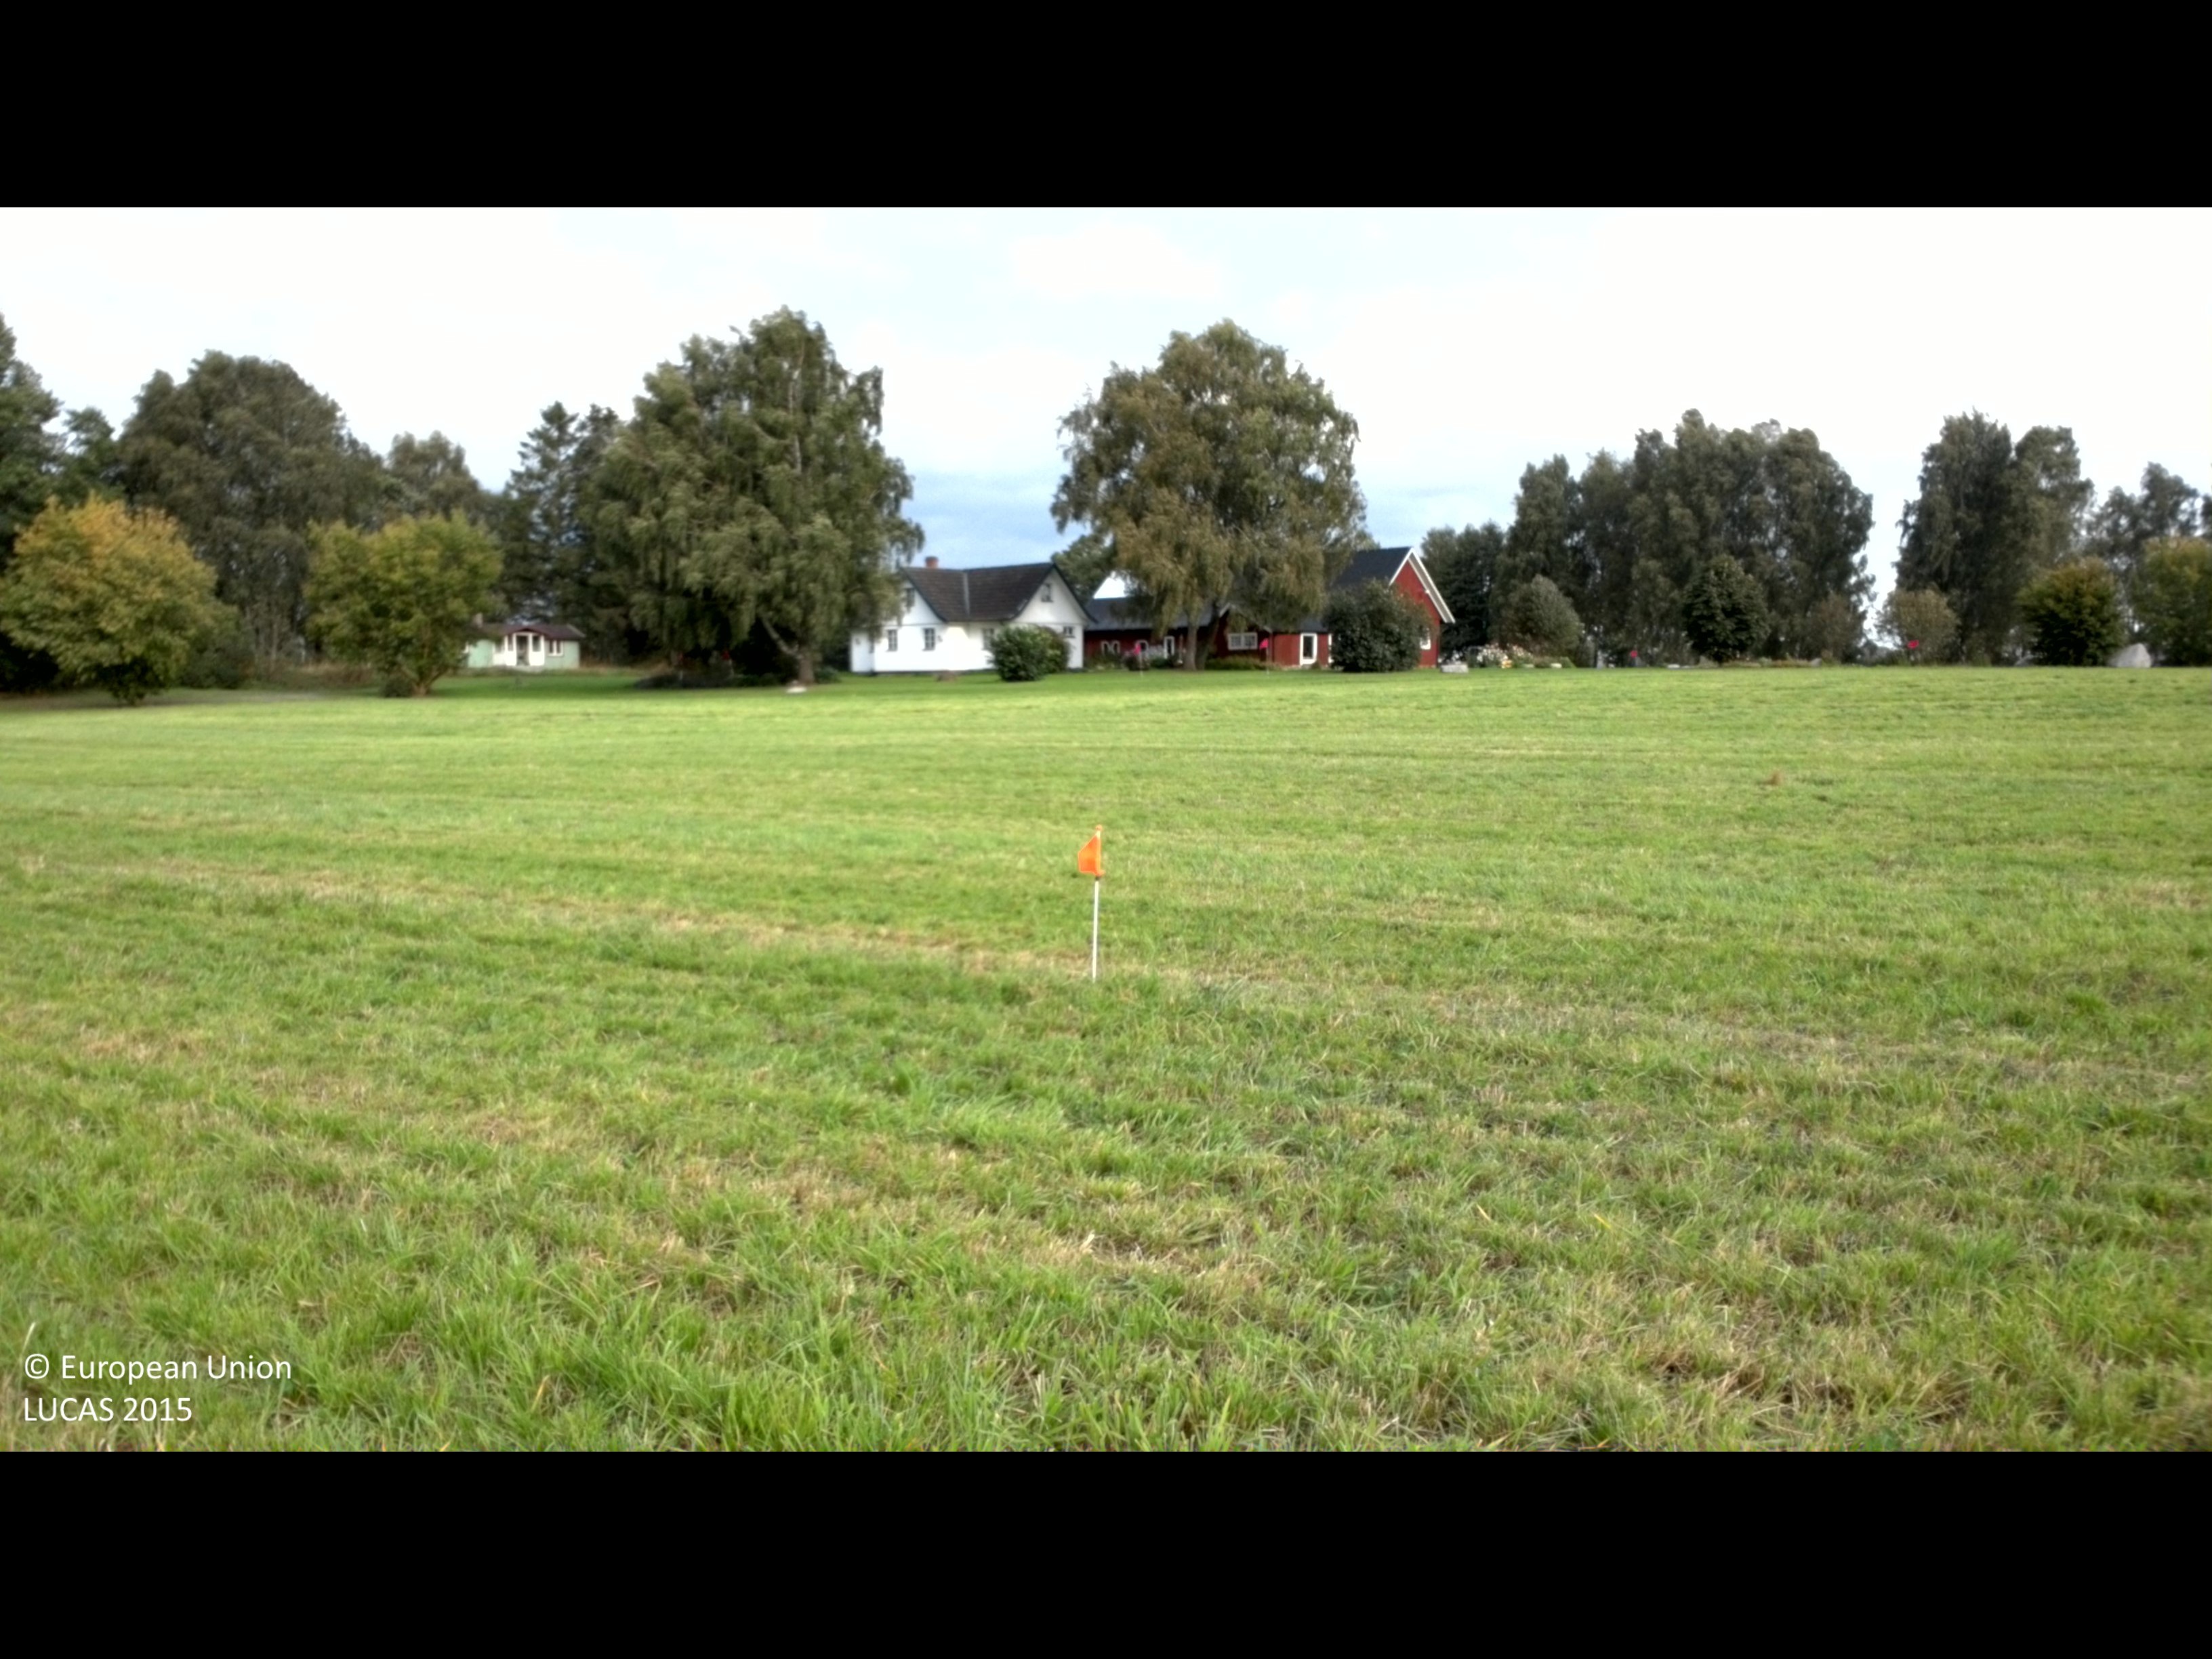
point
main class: Cropland
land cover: Temporary grasslands
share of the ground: > 75 %
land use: Agriculture (excluding fallow land and kitchen gardens)
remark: Harvested field
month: September
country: SE
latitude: 56.2120
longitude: 14.1090
